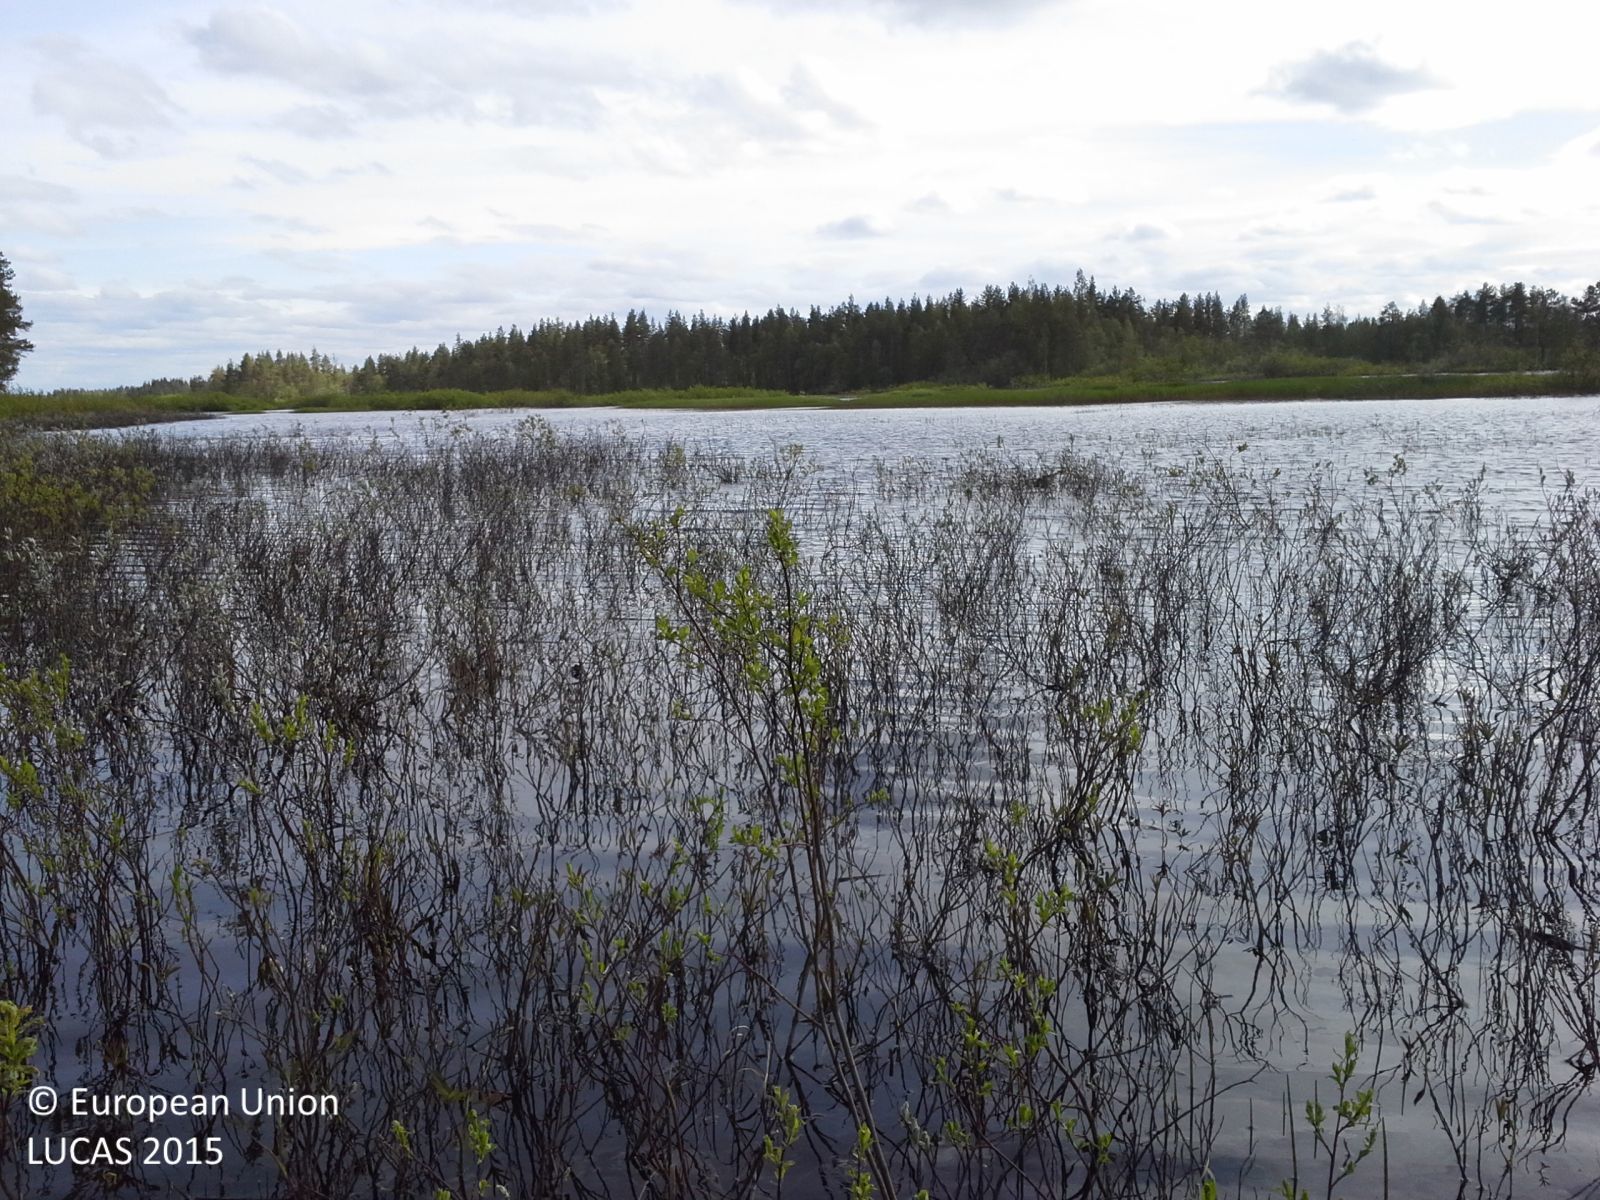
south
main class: Woodland
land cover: Pine dominated mixed woodland
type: boreal forest
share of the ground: 50 - 75 %
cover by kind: coniferous forest trees 40 %, broadleaved forest trees 15 %
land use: Forestry
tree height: > 5 m
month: June
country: FI
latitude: 65.3144
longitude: 26.9617
